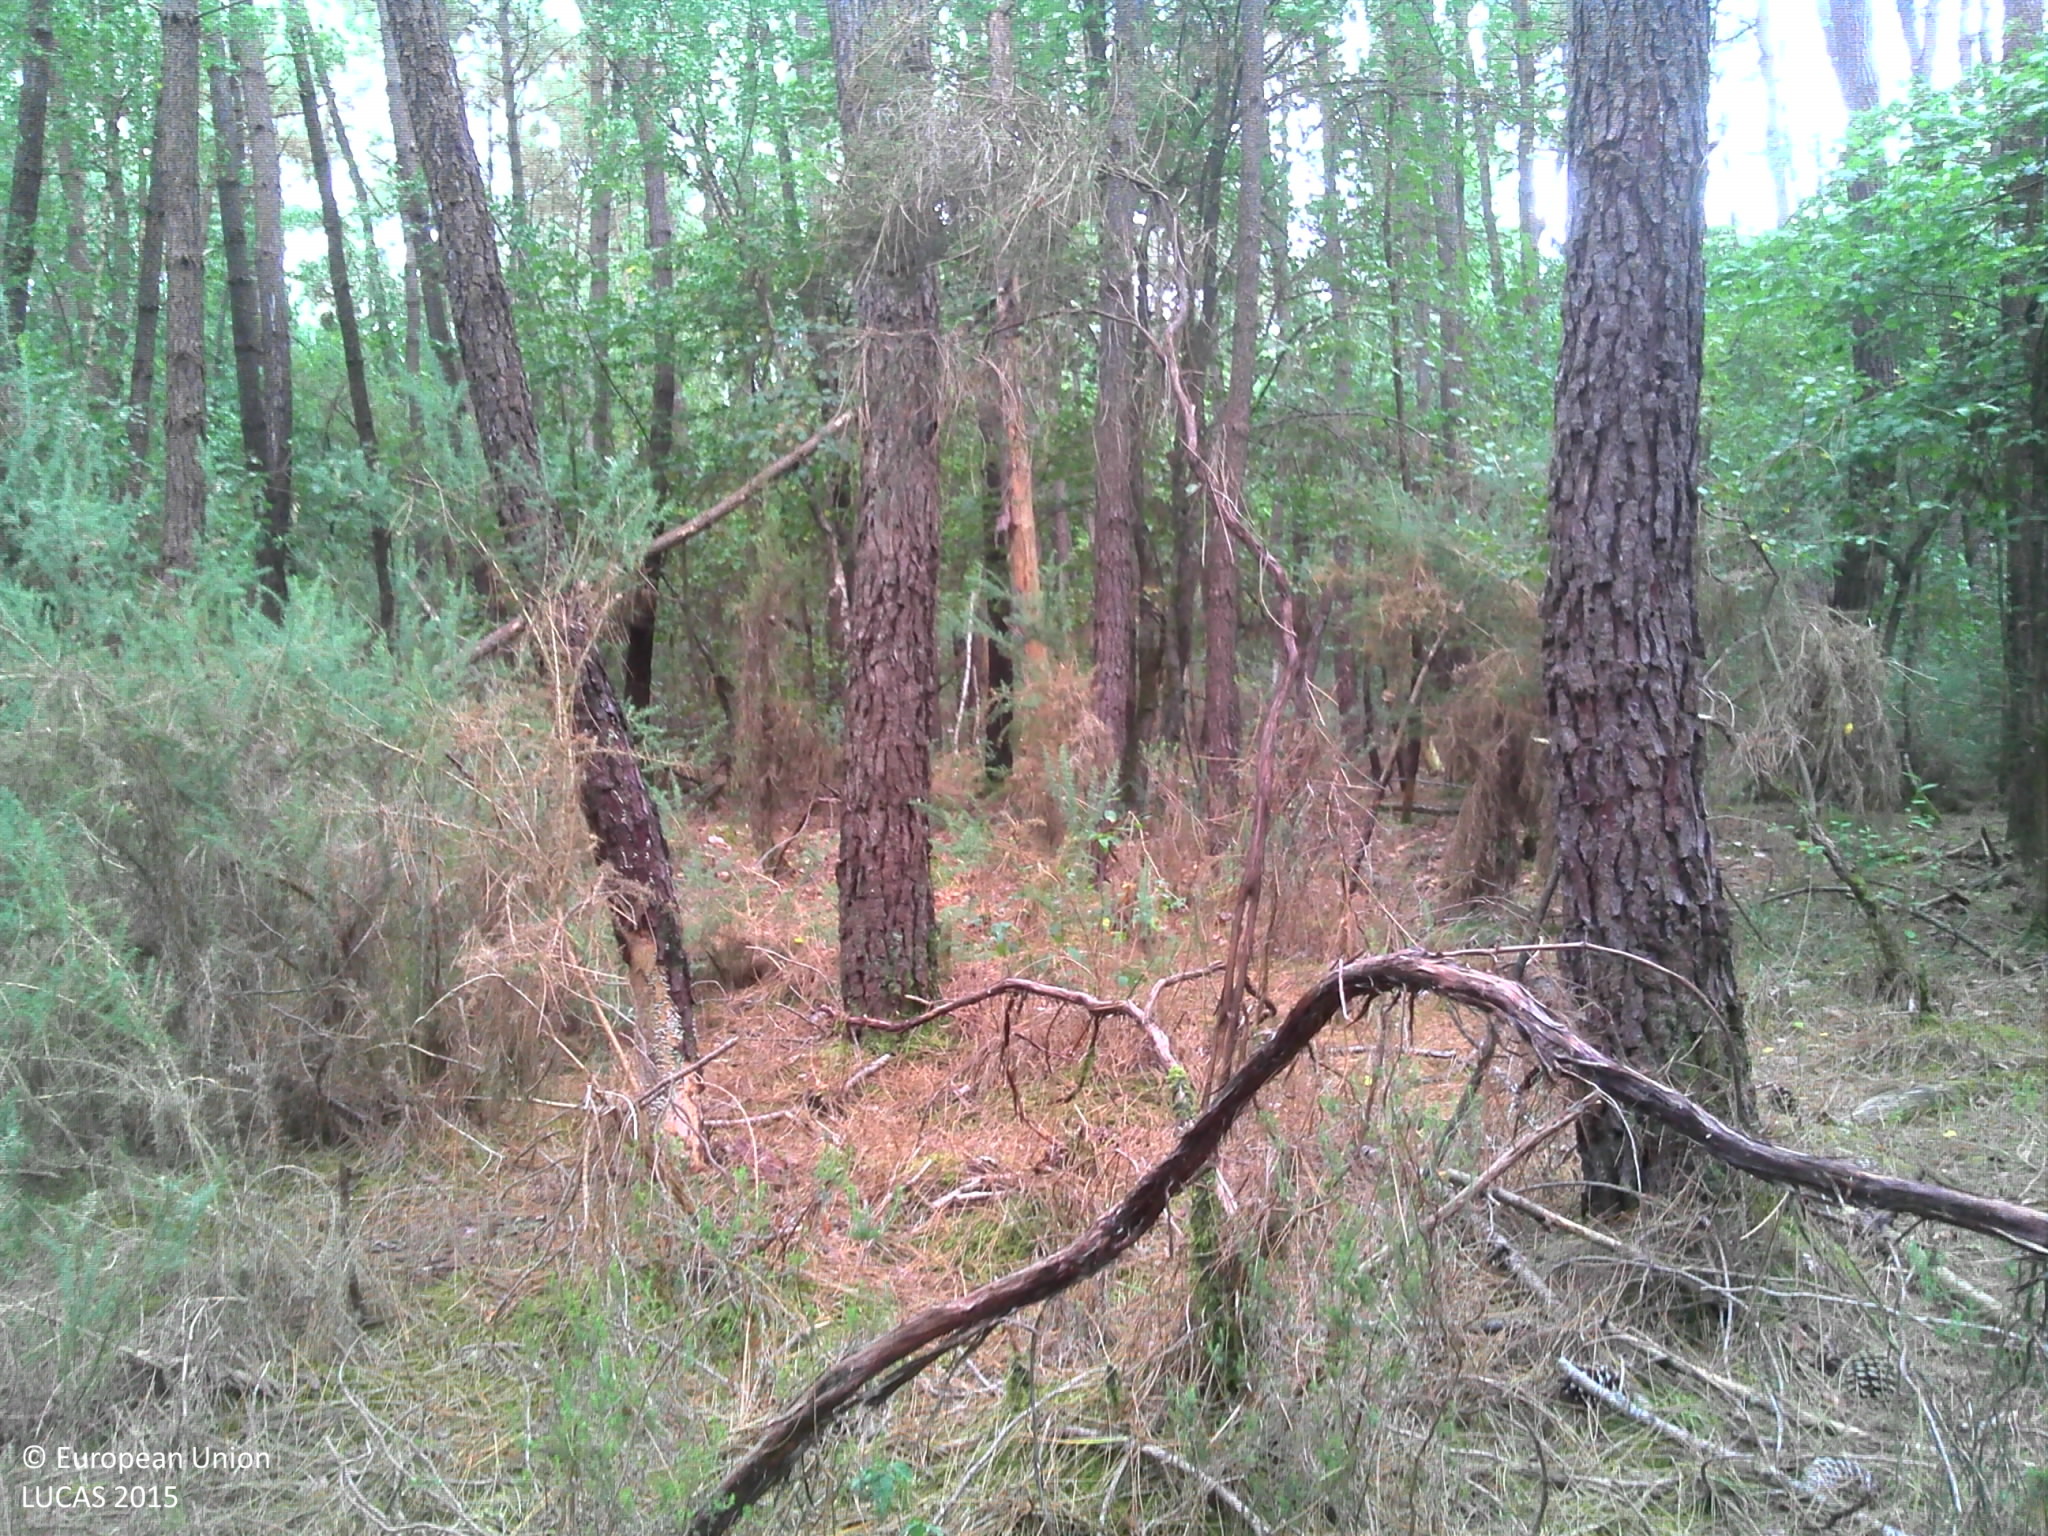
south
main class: Woodland
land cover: Pine dominated mixed woodland
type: hemiboreal forest and nemoral coniferous forest and mixed broadleaved-coniferous forest
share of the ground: > 75 %
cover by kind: coniferous forest trees 50 %, broadleaved forest trees 20 %, shrubs 15 %, herbaceous plants 10 %, lichens and mosses 5 %
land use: Forestry
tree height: > 5 m
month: July
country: FR
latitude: 46.9900
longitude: 0.4208
